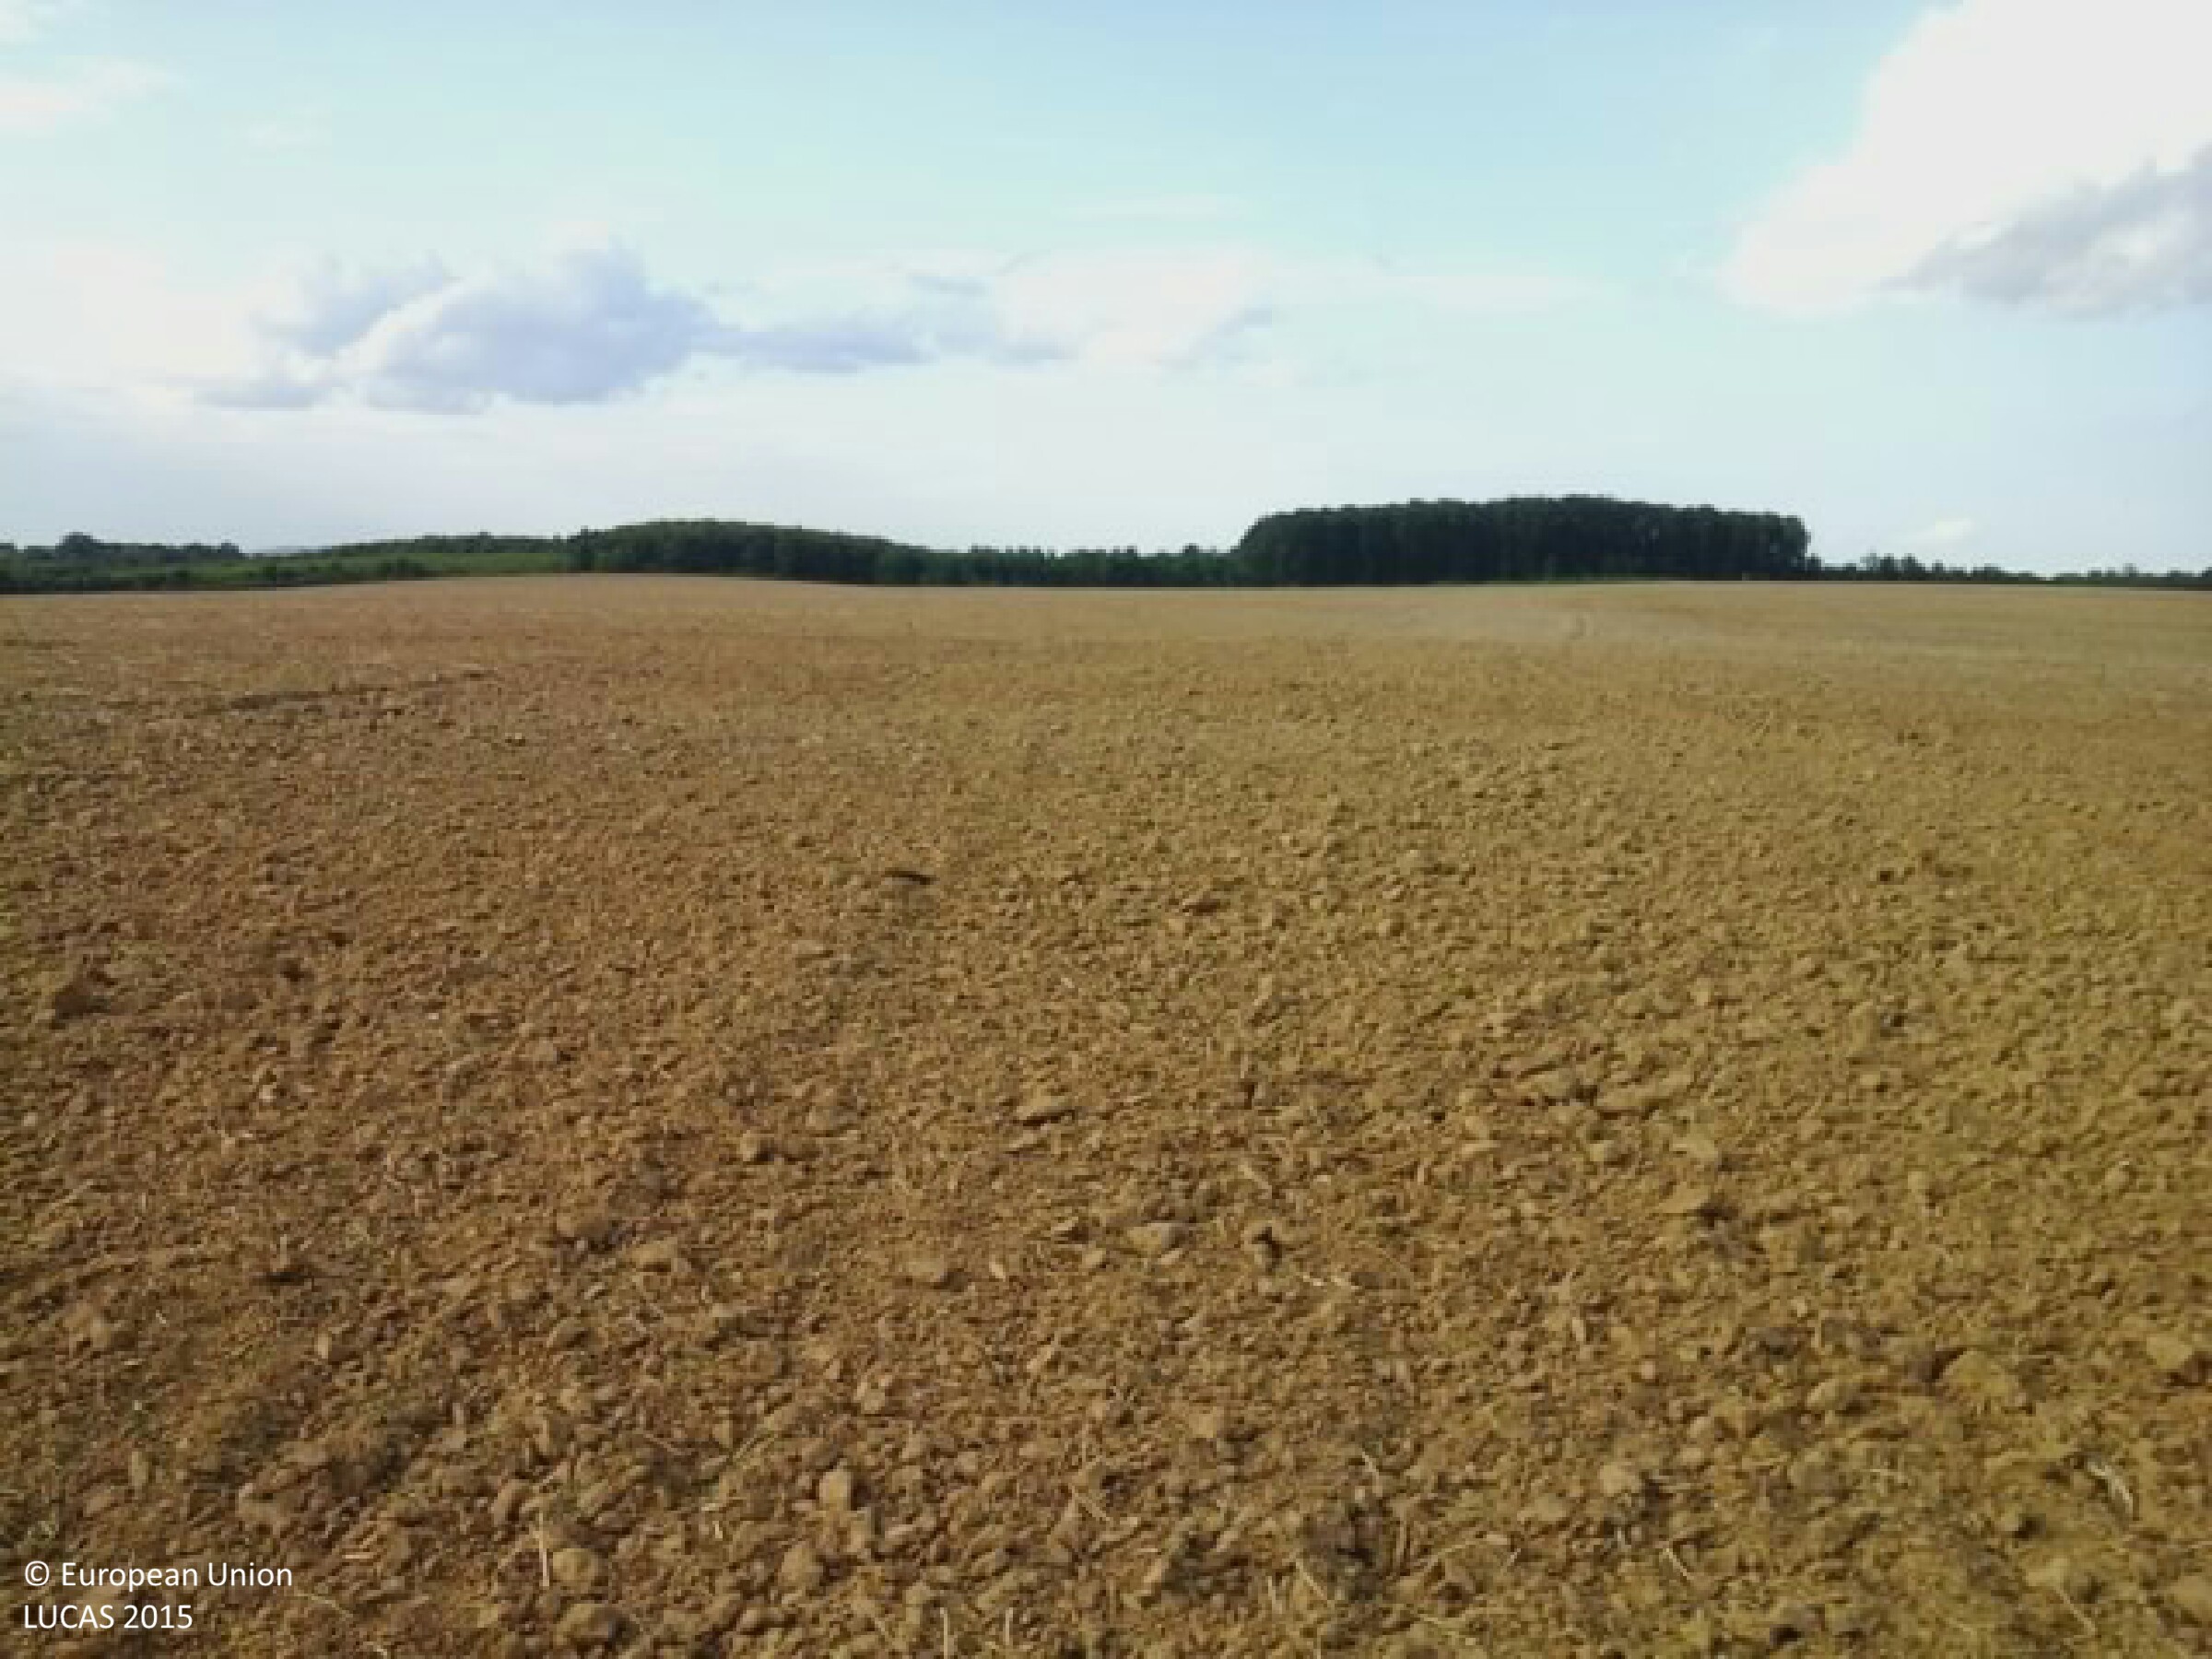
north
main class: Cropland
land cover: Rape and turnip rape
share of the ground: < 10 %
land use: Agriculture (excluding fallow land and kitchen gardens)
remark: Harvested field
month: July
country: HU
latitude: 46.4100
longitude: 17.0144
